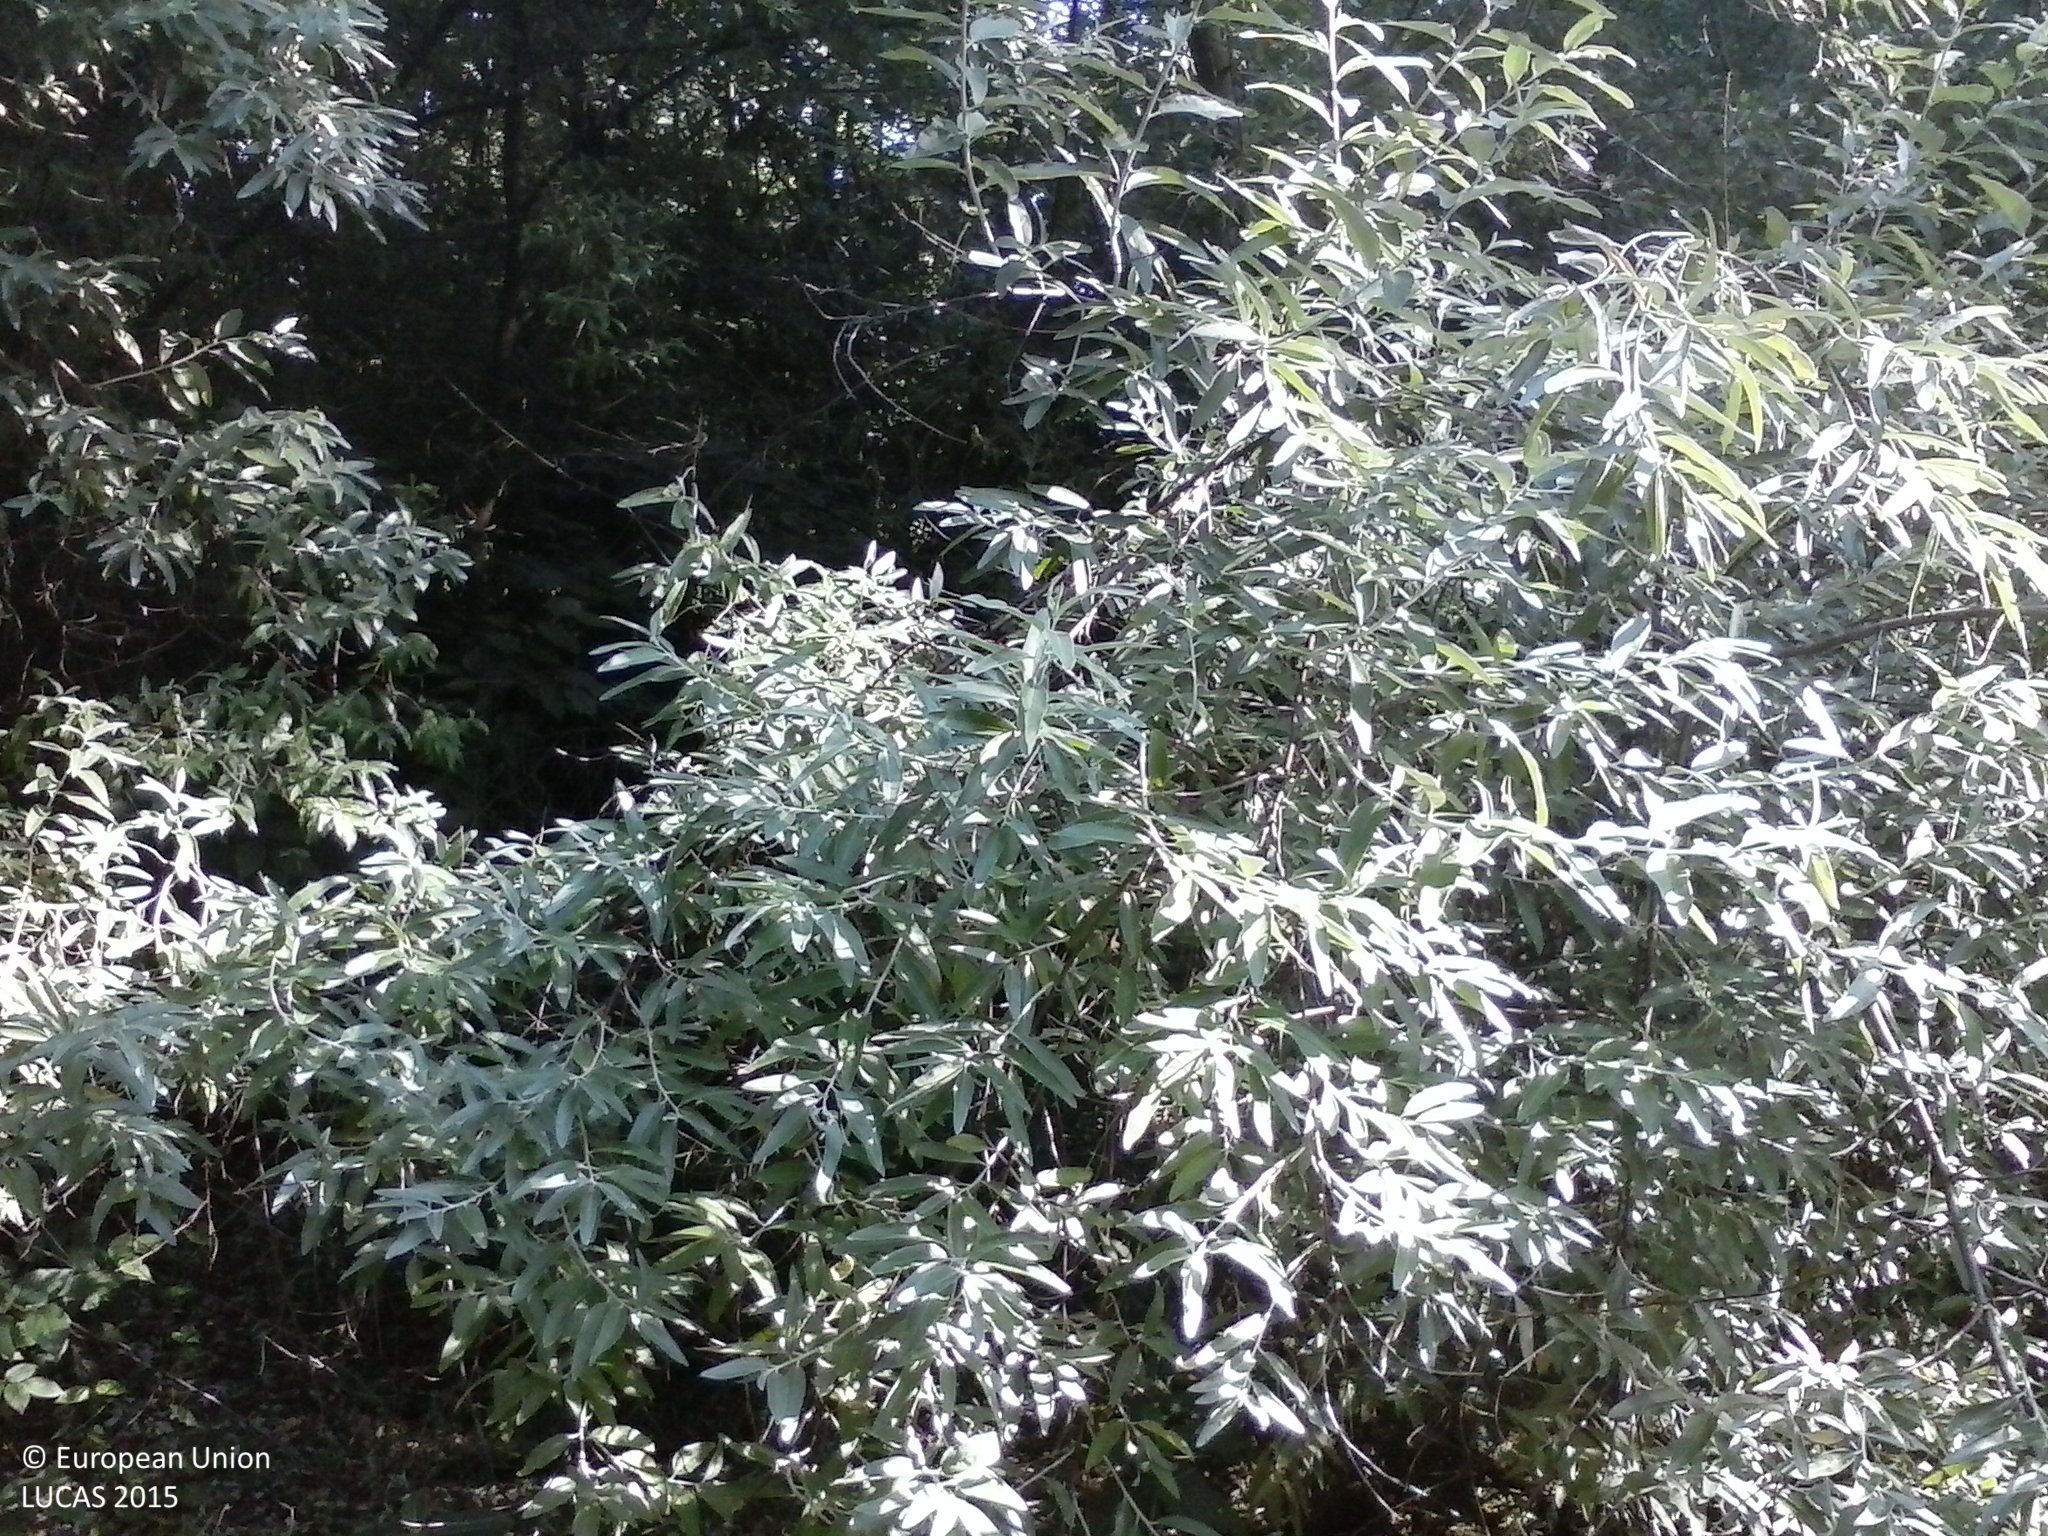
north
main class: Woodland
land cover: Pine dominated coniferous woodland
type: hemiboreal forest and nemoral coniferous forest and mixed broadleaved-coniferous forest
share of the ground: > 75 %
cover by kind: coniferous forest trees 70 %, broadleaved forest trees 20 %, shrubs 5 %, herbaceous plants 5 %
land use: Forestry
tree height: > 5 m
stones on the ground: < 10 %
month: July
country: HU
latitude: 46.3114
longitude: 19.6662
